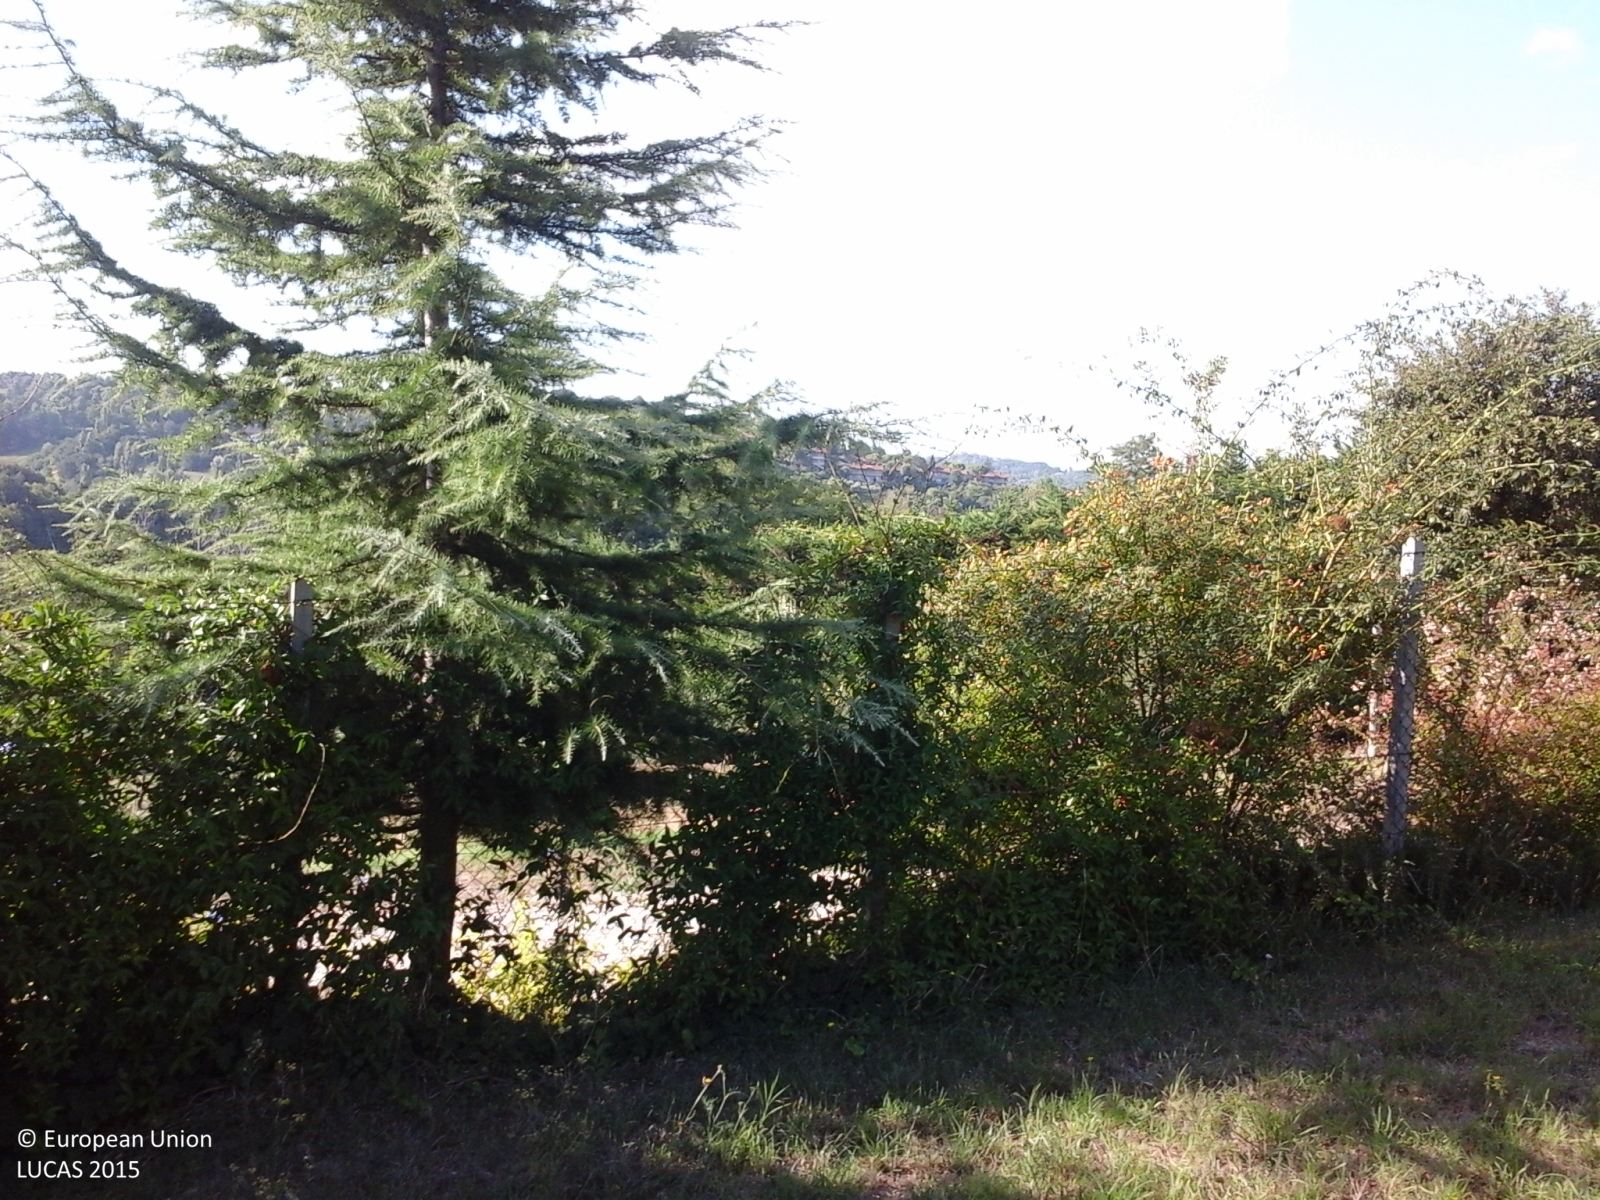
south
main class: Woodland
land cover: Broadleaved woodland
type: thermophilous deciduous forest
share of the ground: > 75 %
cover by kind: broadleaved forest trees 100 %
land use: Forestry
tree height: > 5 m
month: September
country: IT
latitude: 43.8937
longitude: 12.9436
